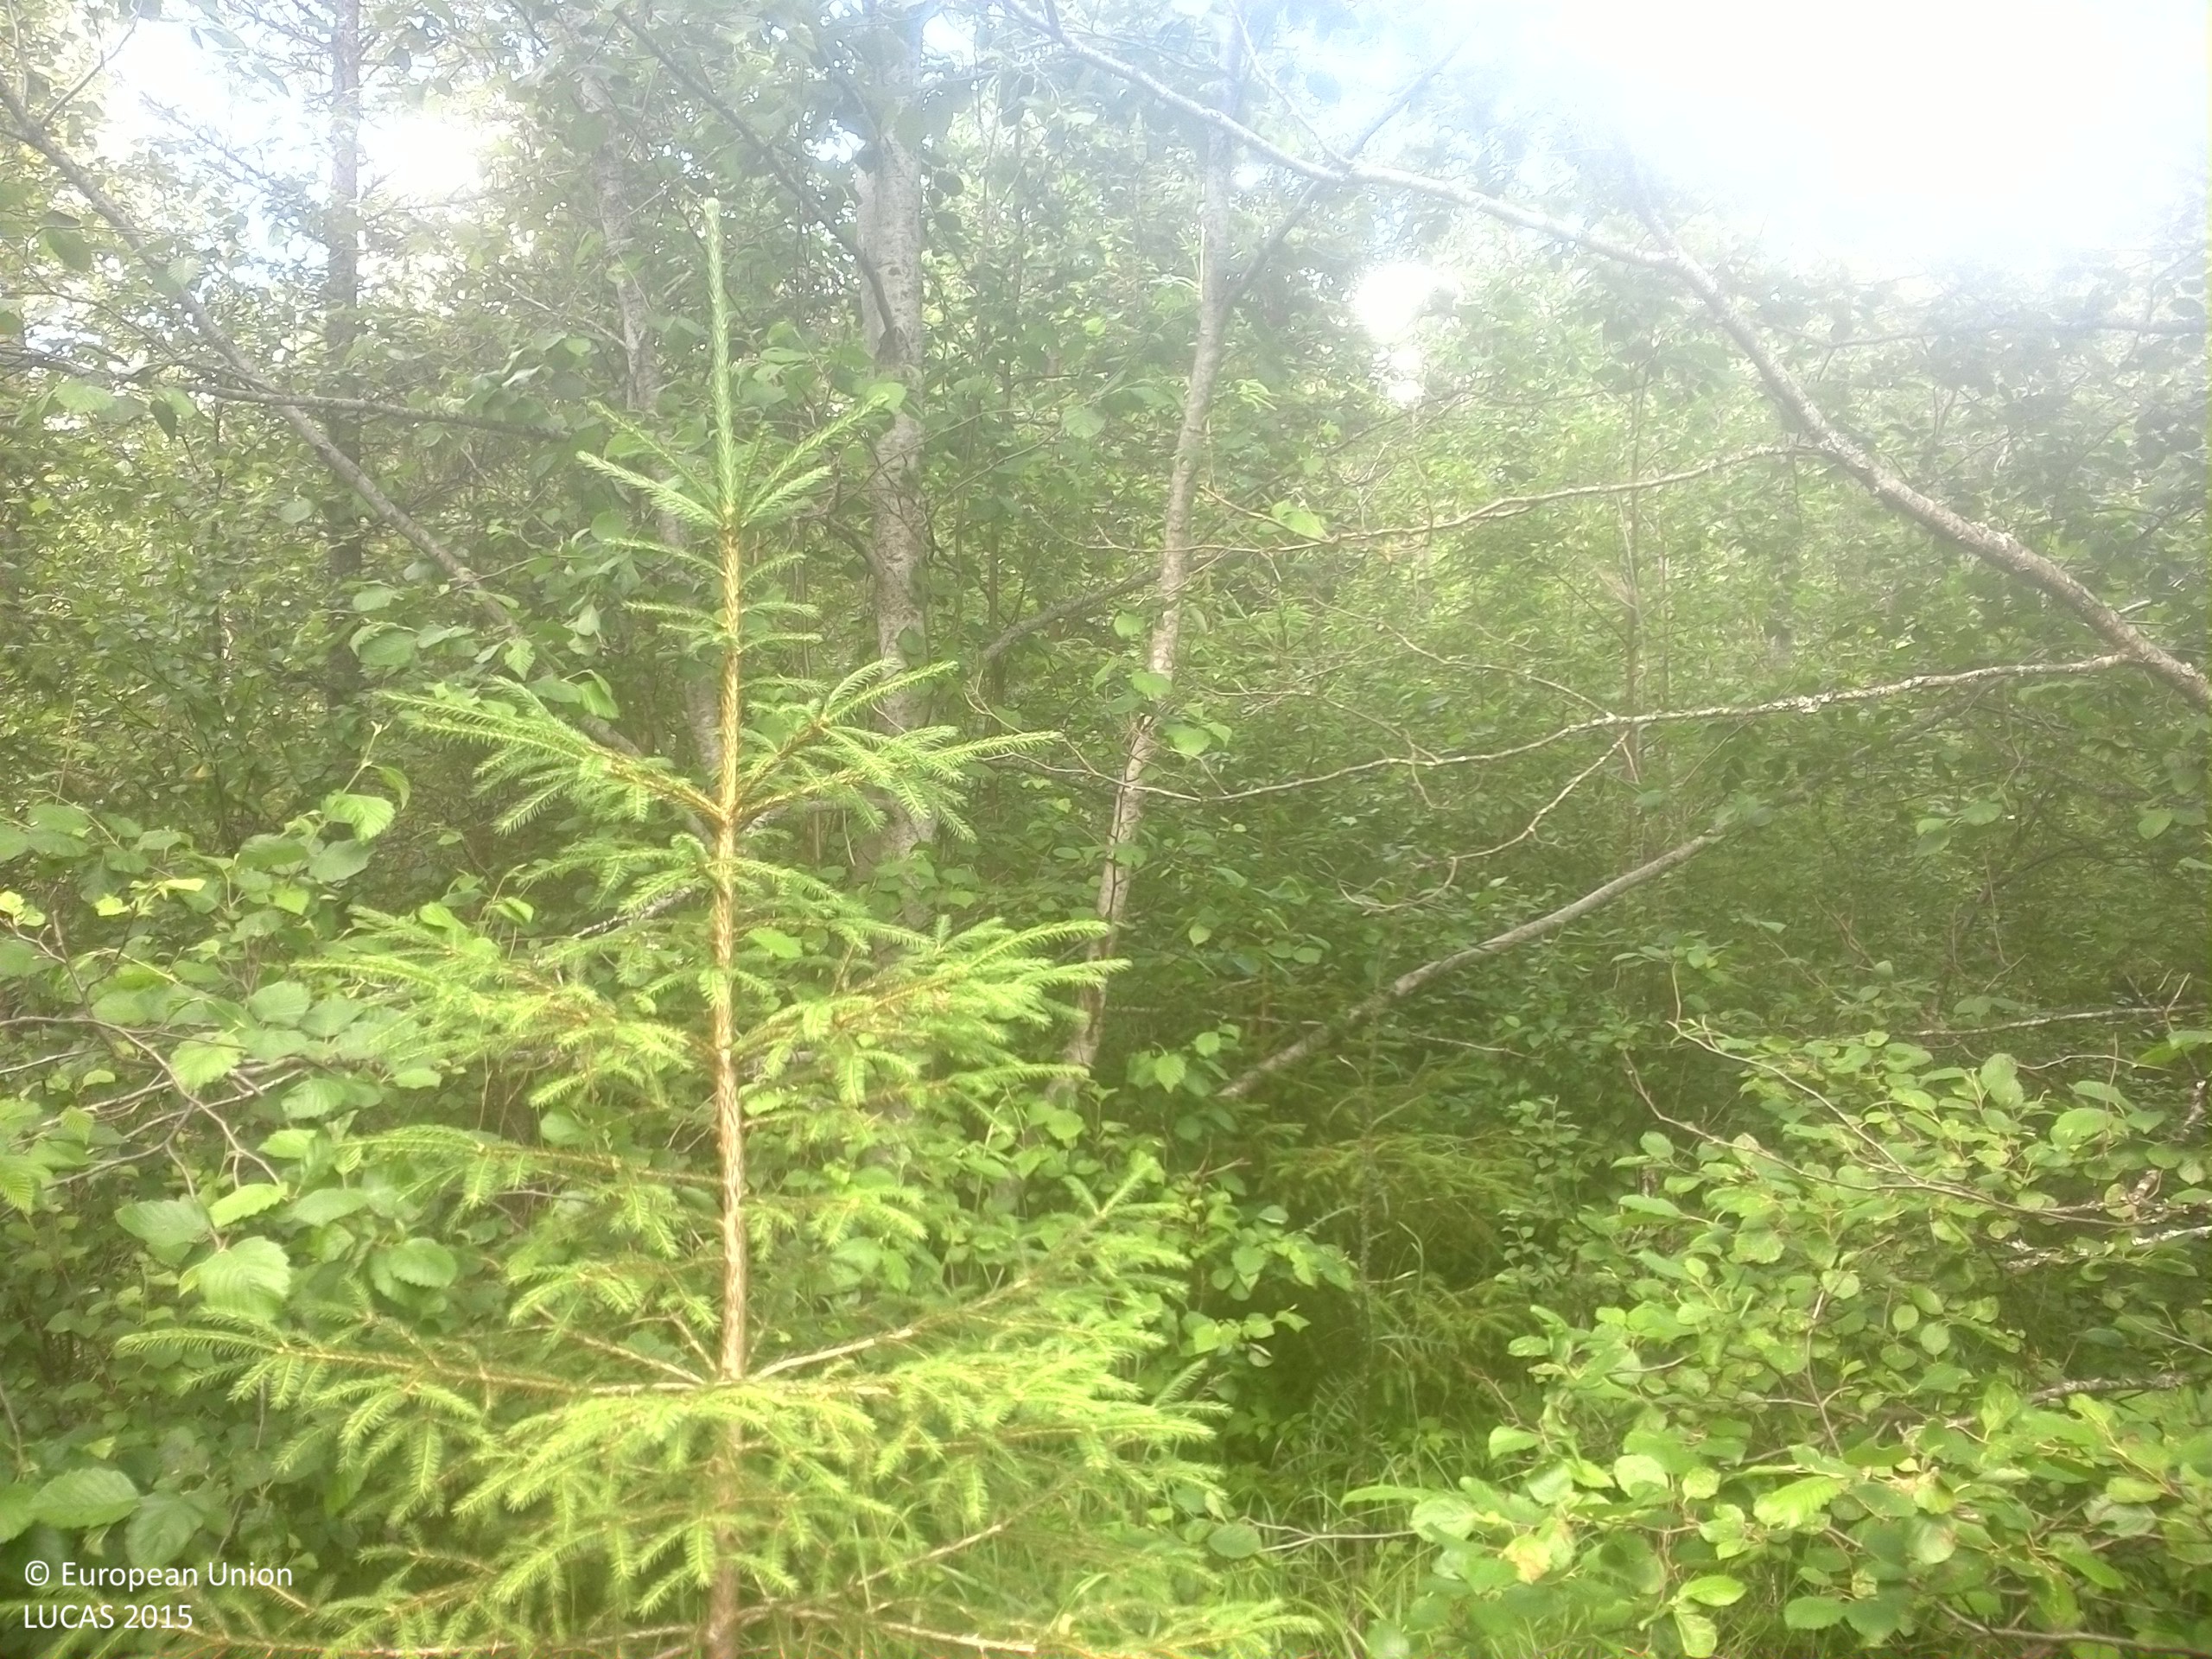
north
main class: Woodland
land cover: Spruce dominated mixed woodland
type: boreal forest
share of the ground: > 75 %
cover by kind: coniferous forest trees 40 %, broadleaved forest trees 35 %, herbaceous plants 15 %, shrubs 10 %
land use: Forestry
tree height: > 5 m
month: July
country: SE
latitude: 62.7140
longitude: 17.1543
